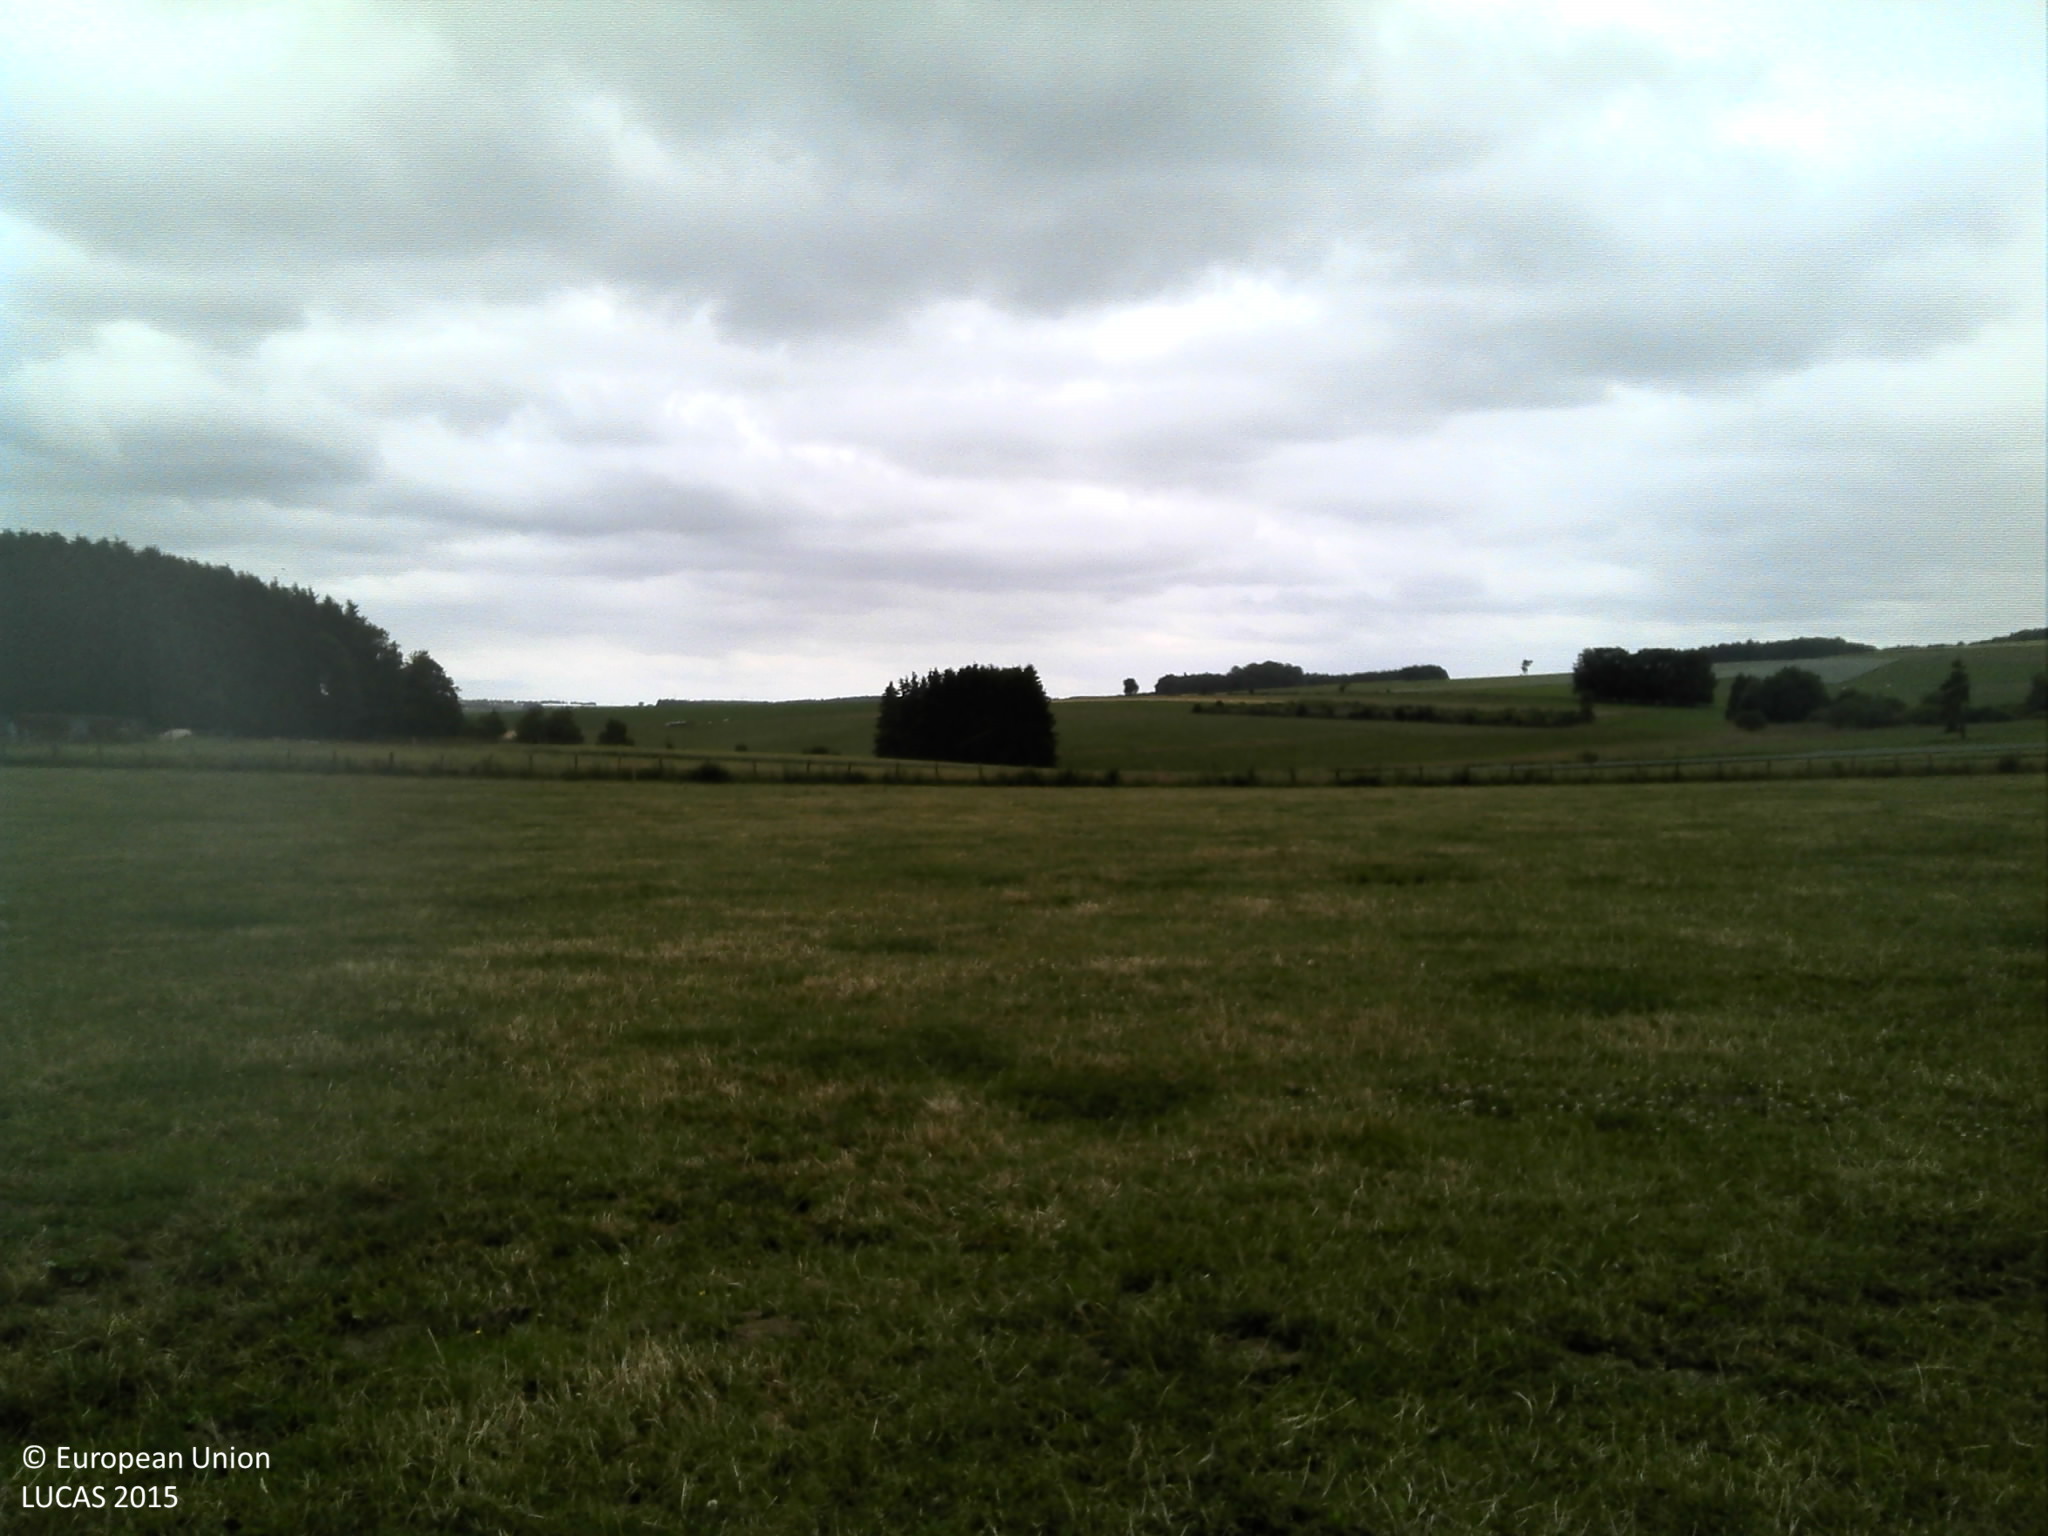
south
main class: Grassland
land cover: Grassland without tree/shrub cover
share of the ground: > 75 %
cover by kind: herbaceous plants 100 %
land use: Agriculture (excluding fallow land and kitchen gardens)
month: July
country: LU
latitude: 50.0937
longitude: 5.9313
